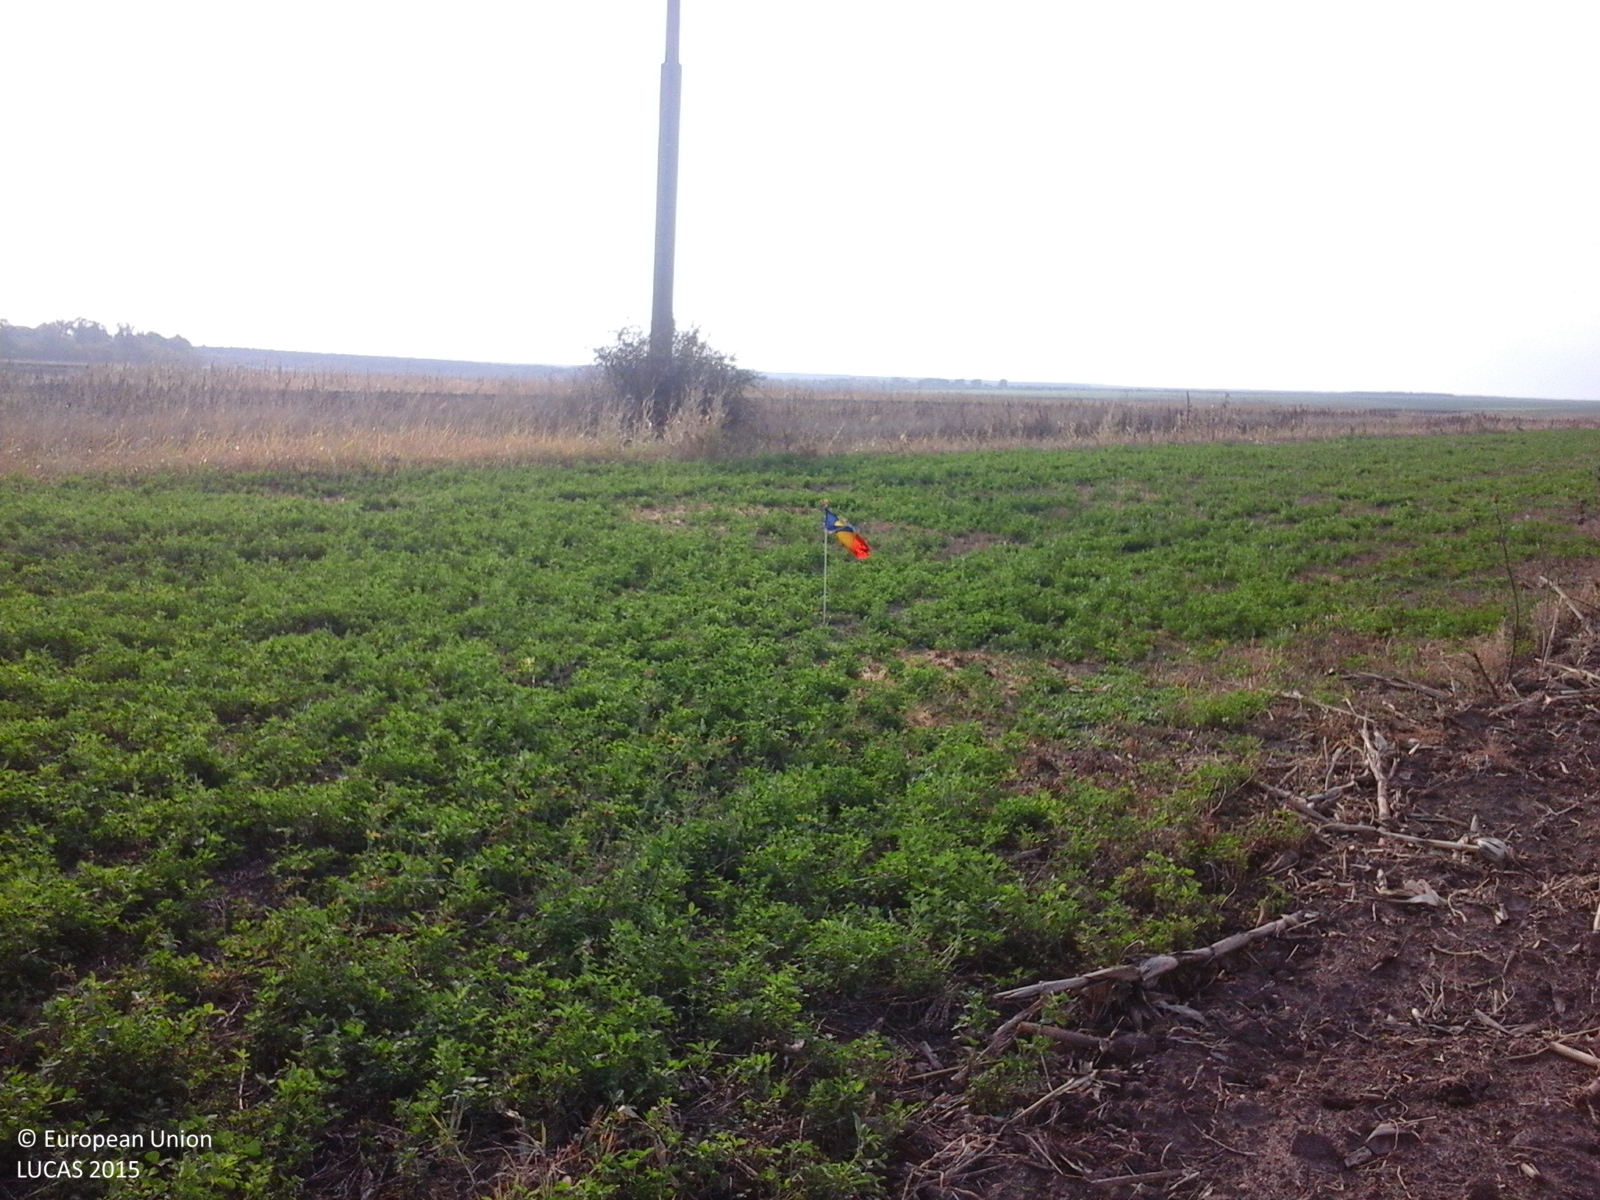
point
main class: Cropland
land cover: Lucerne
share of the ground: > 75 %
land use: Agriculture (excluding fallow land and kitchen gardens)
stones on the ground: < 10 %
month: October
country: RO
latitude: 45.4775
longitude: 27.0916
